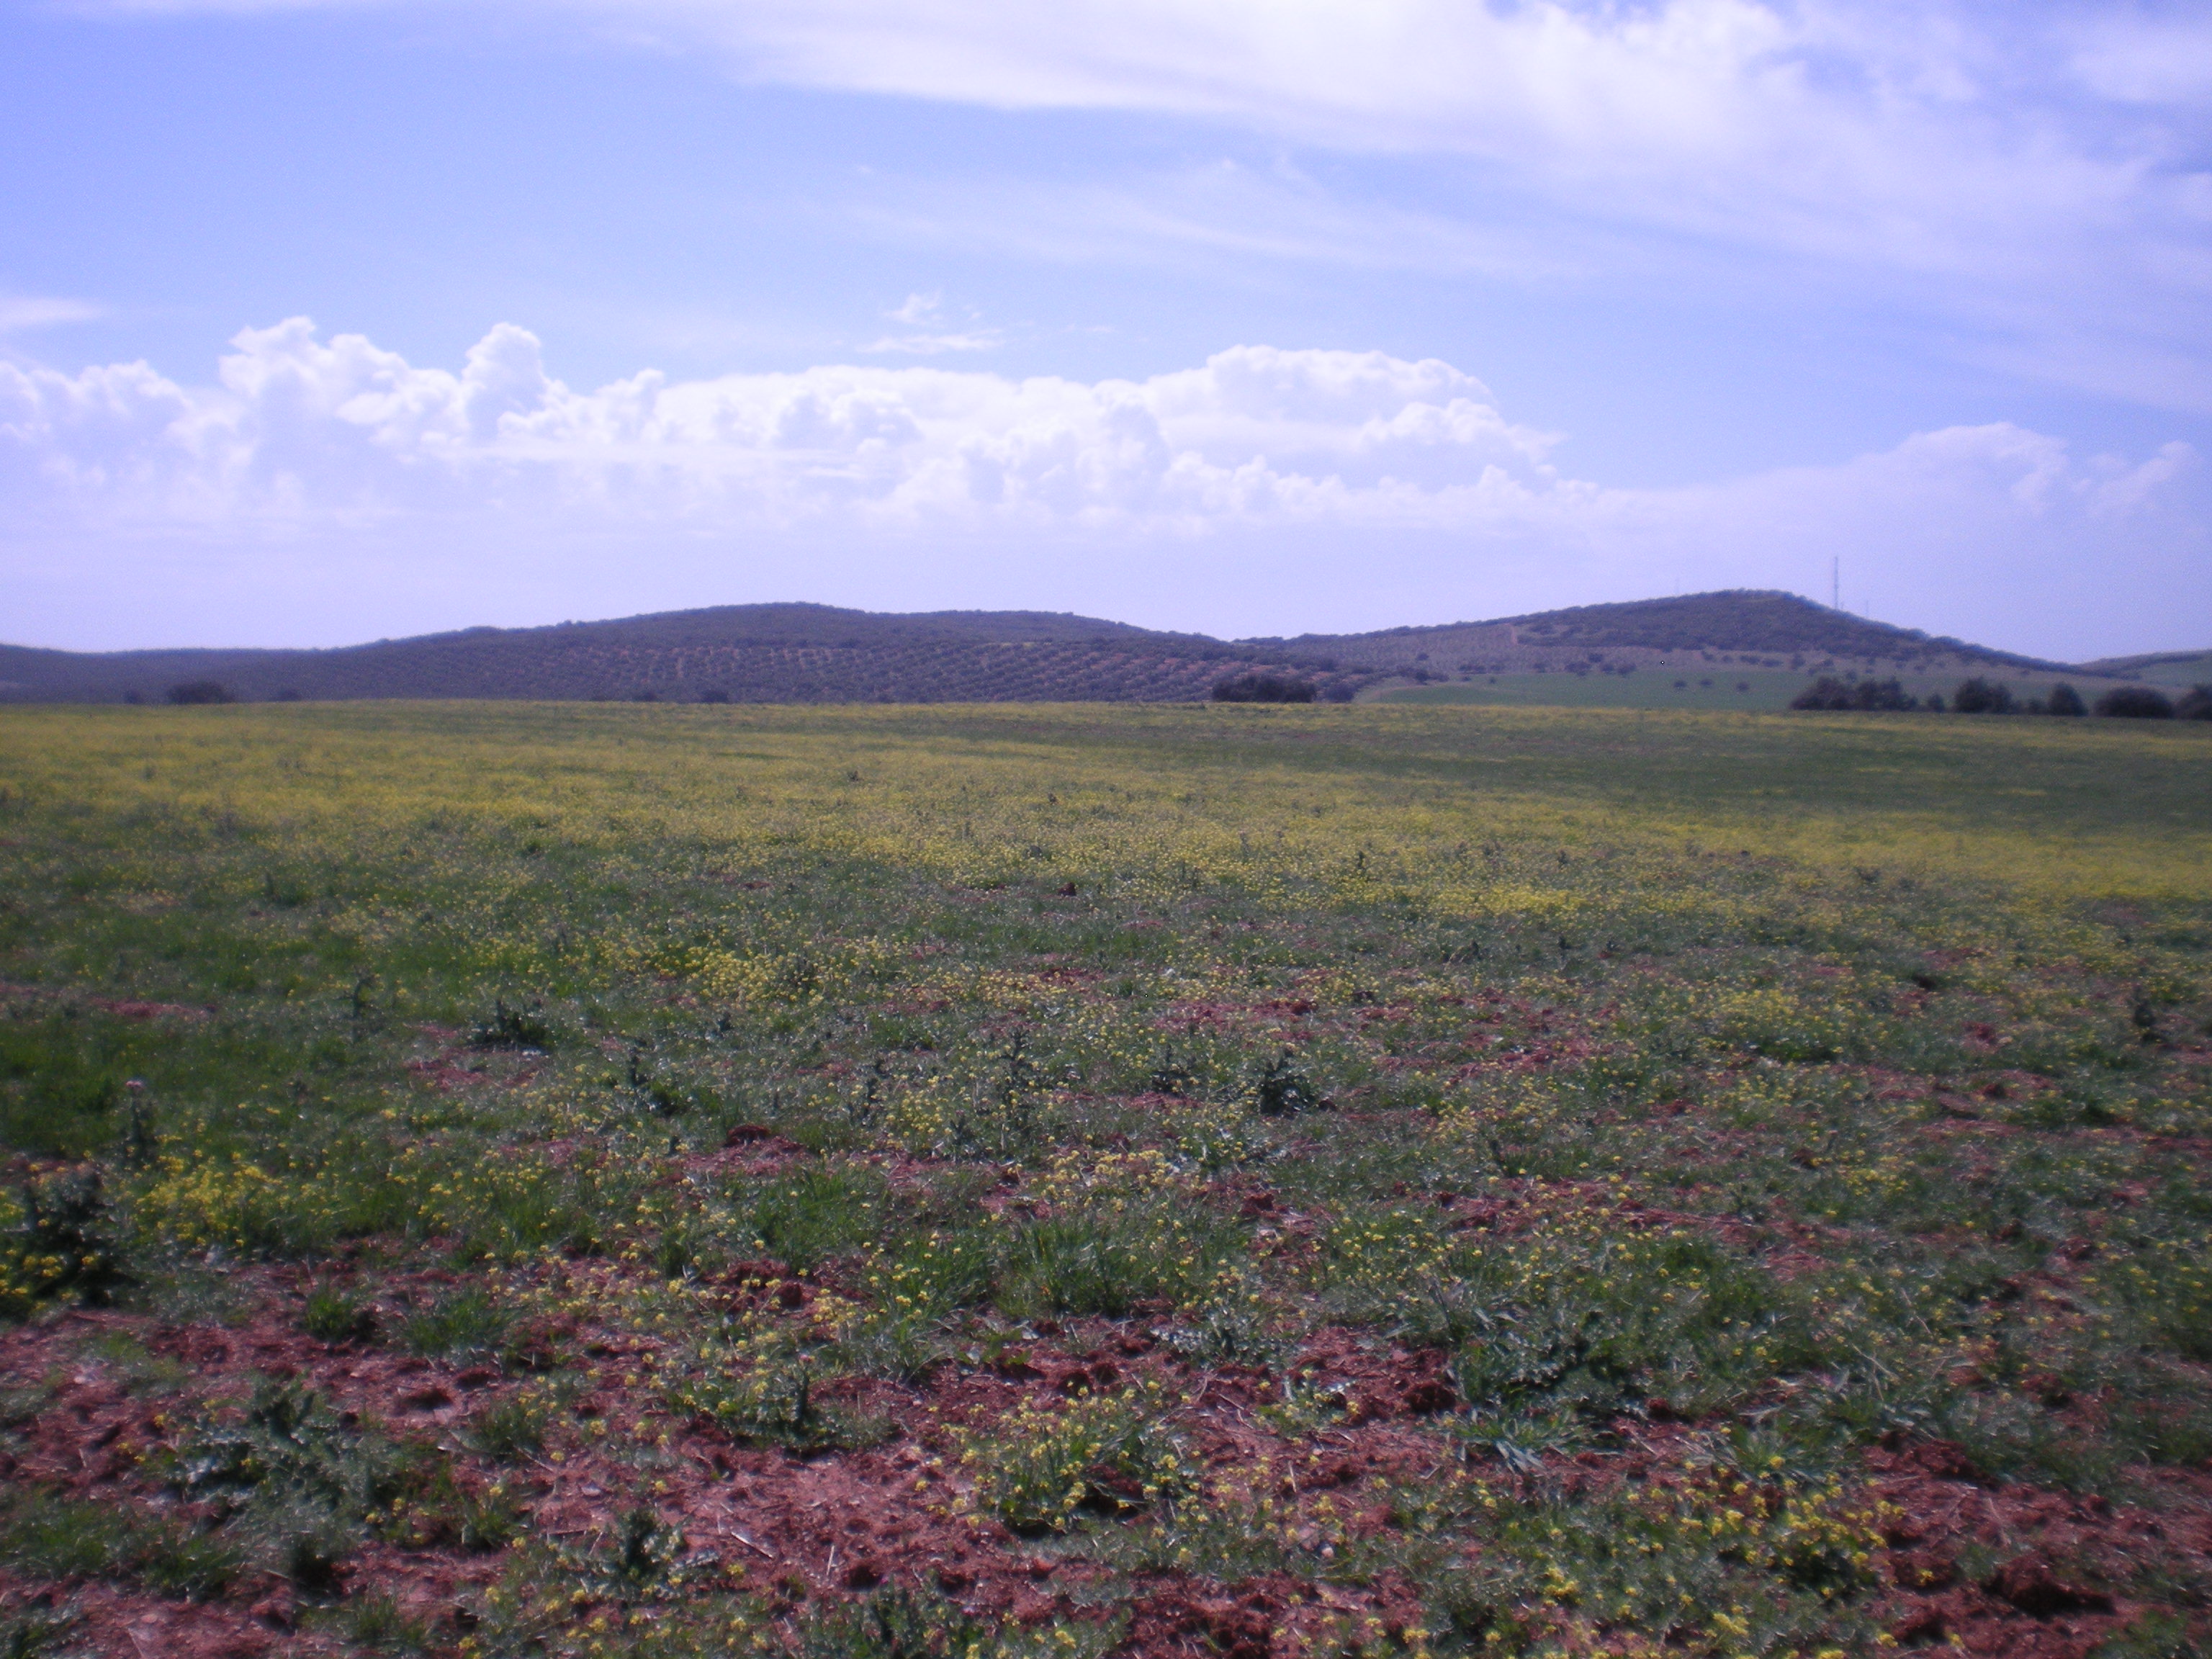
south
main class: Grassland
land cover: Spontaneously vegetated surfaces
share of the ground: > 75 %
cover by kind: unconsolidated bare surface 60 %, herbaceous plants 40 %
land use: Agriculture (excluding fallow land and kitchen gardens)
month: April
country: ES
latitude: 38.5429
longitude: -3.4900
